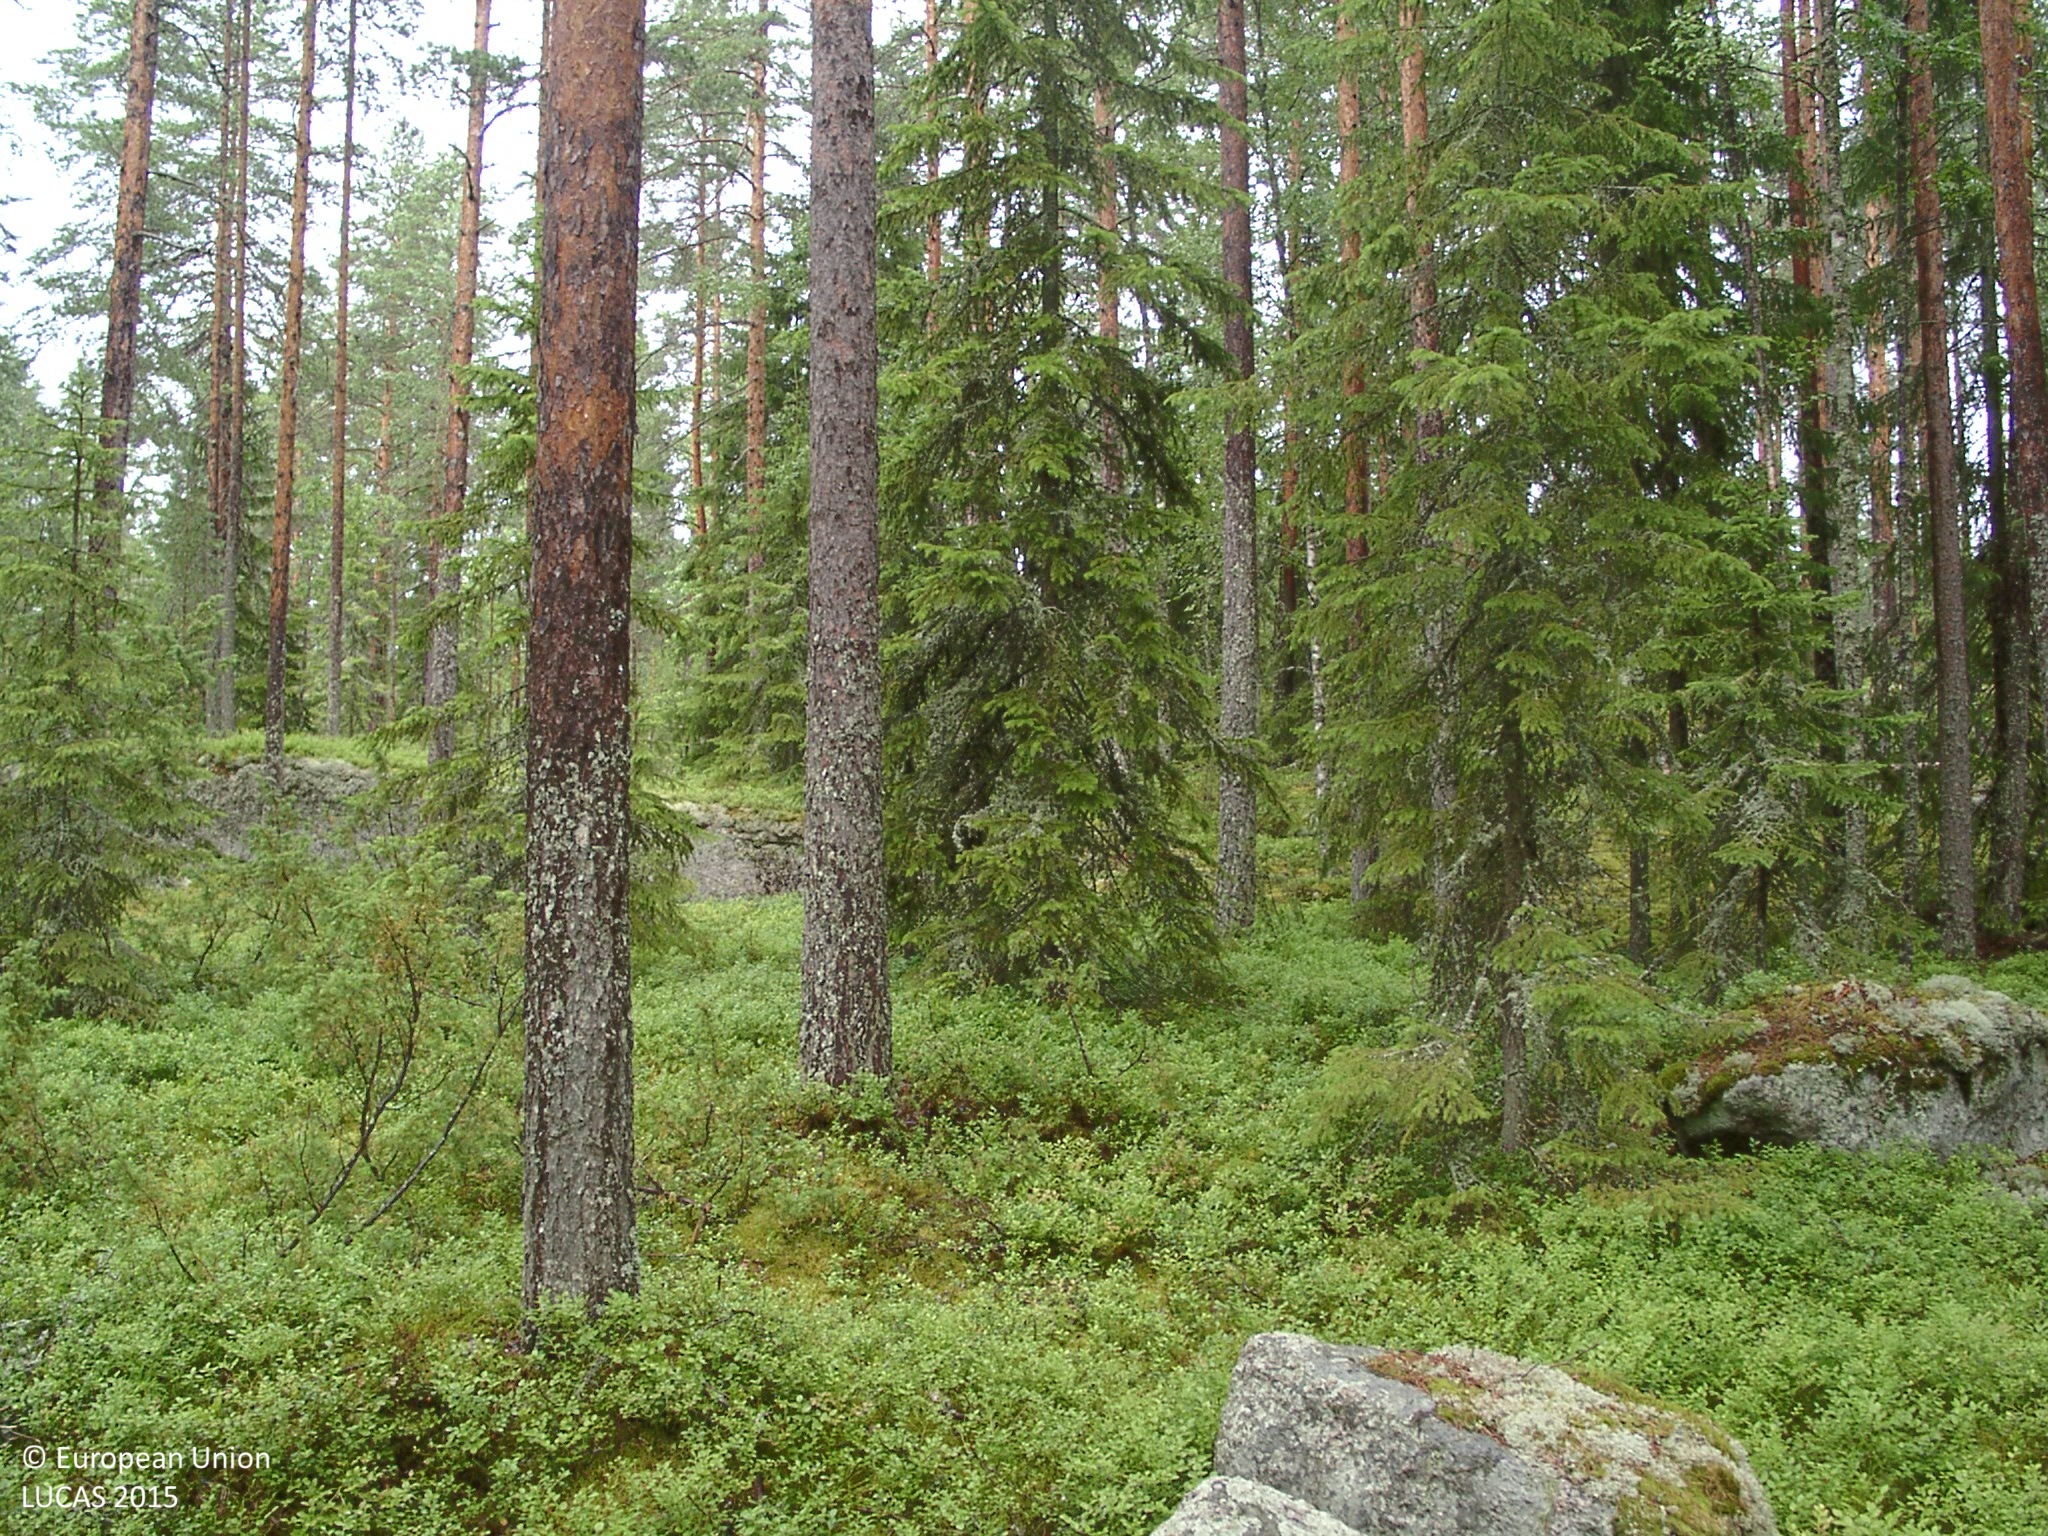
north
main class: Woodland
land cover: Other coniferous woodland
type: boreal forest
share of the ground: 50 - 75 %
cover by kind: coniferous forest trees 55 %, shrubs 25 %, broadleaved forest trees 10 %, lichens and mosses 10 %
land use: Forestry
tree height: > 5 m
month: July
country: FI
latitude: 61.9343
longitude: 25.2974
